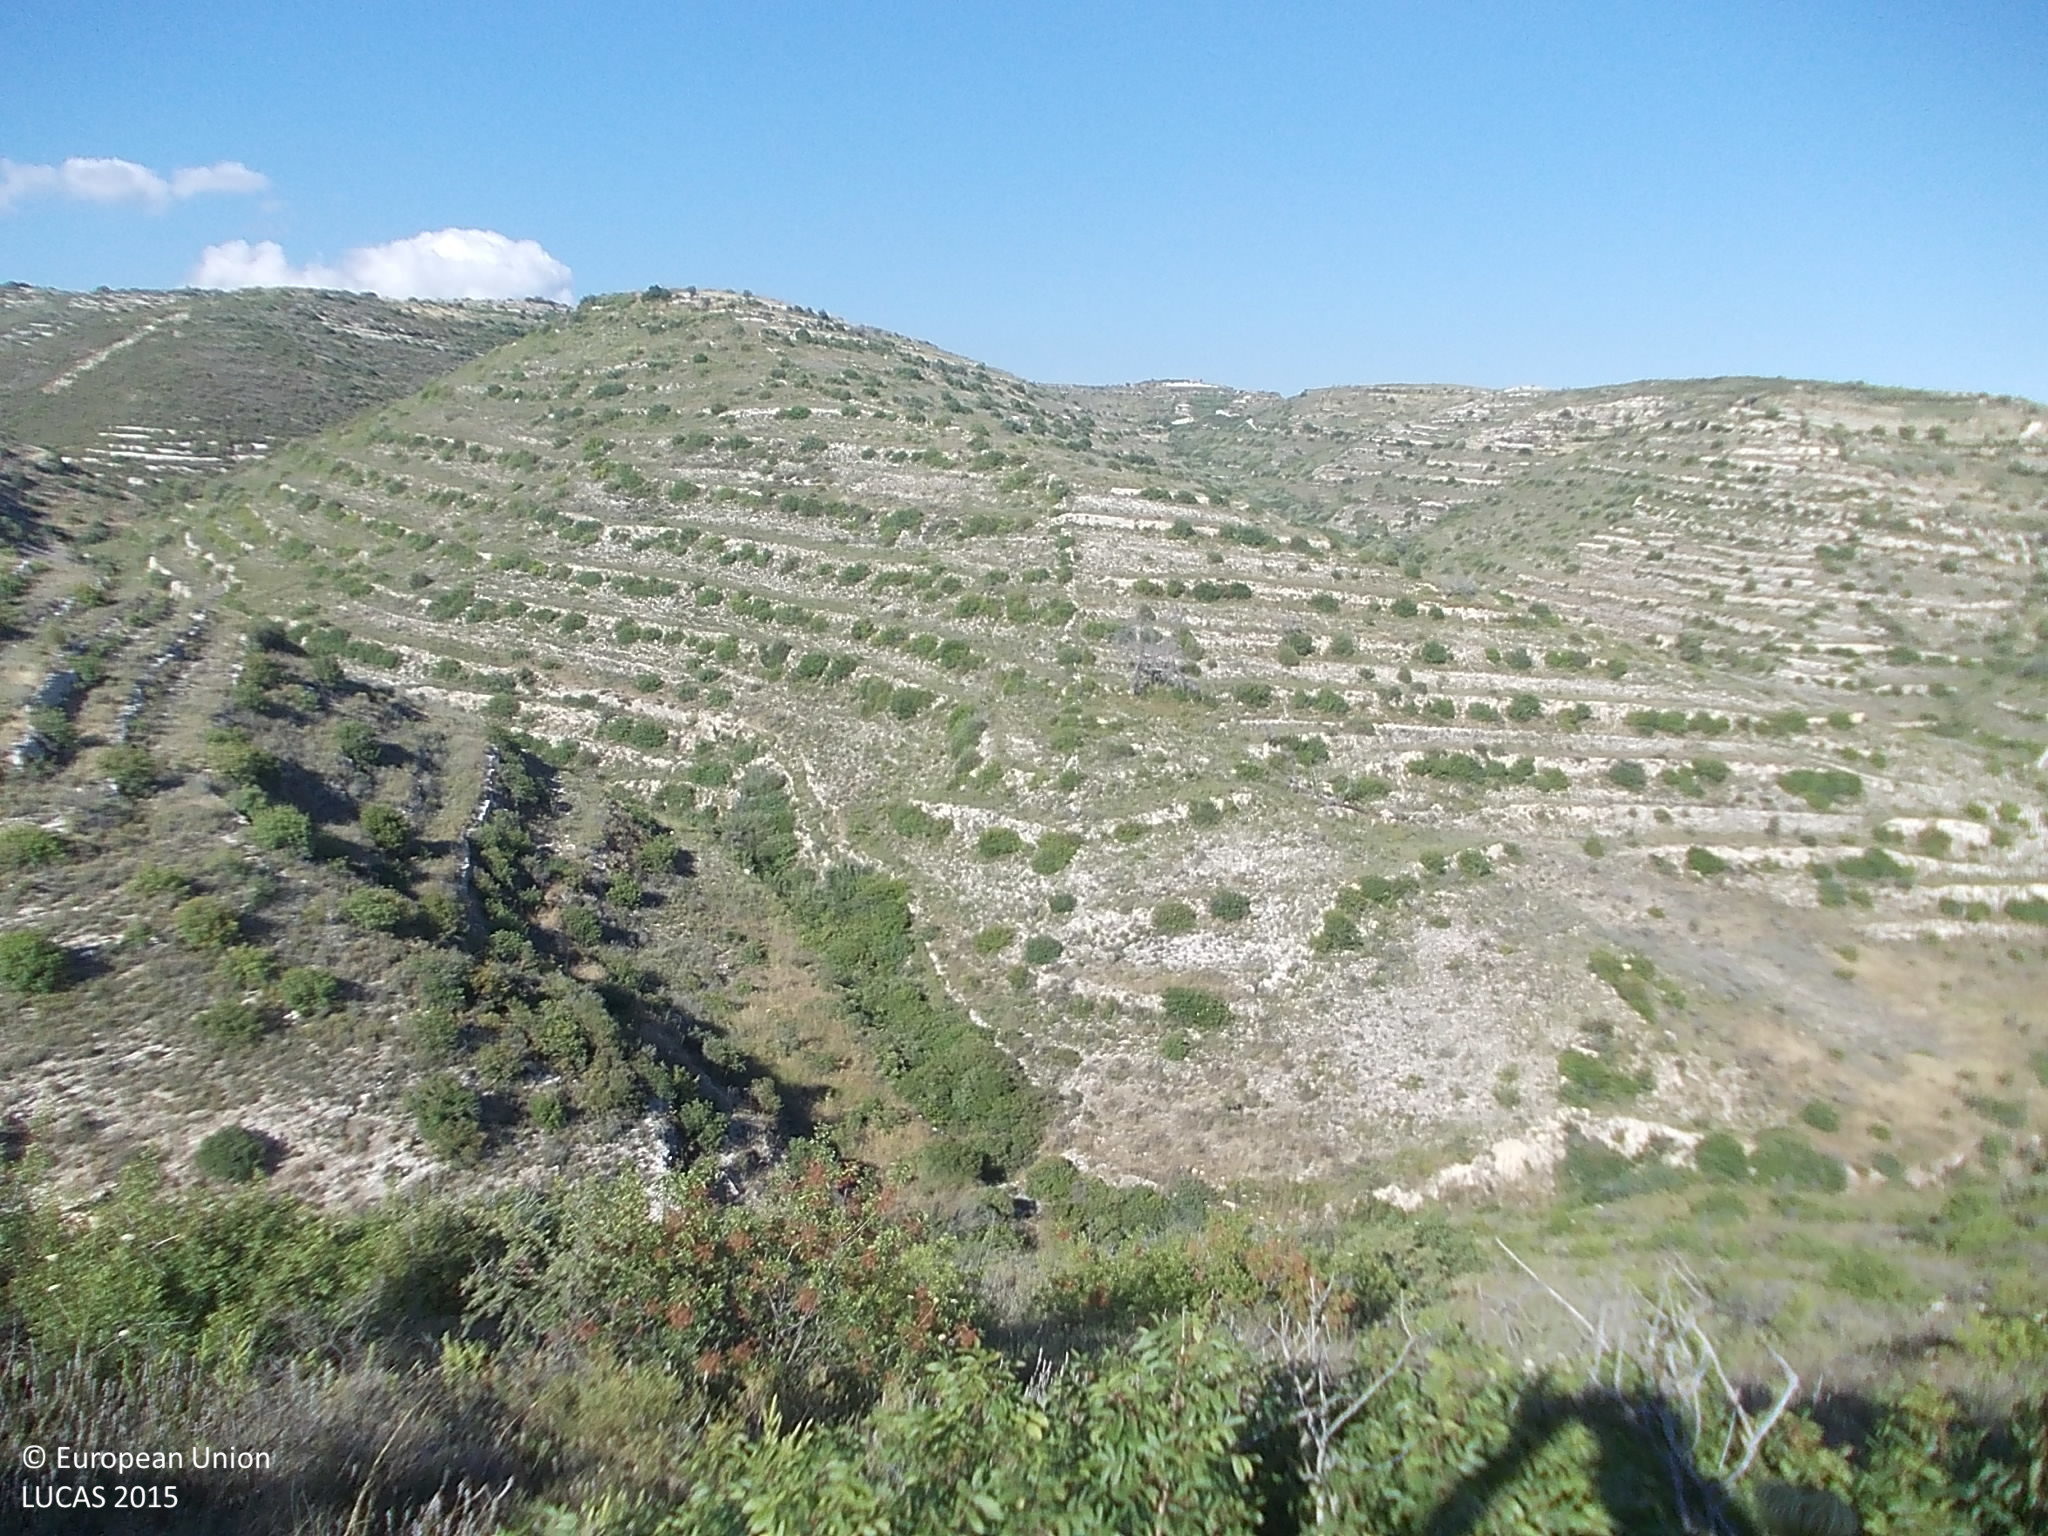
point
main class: Shrubland
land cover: Shrubland without tree cover
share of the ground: 50 - 75 %
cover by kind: shrubs 65 %, unconsolidated bare surface 20 %, herbaceous plants 15 %
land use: Semi-natural and natural areas not in use
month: July
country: CY
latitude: 34.8372
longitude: 32.8304
